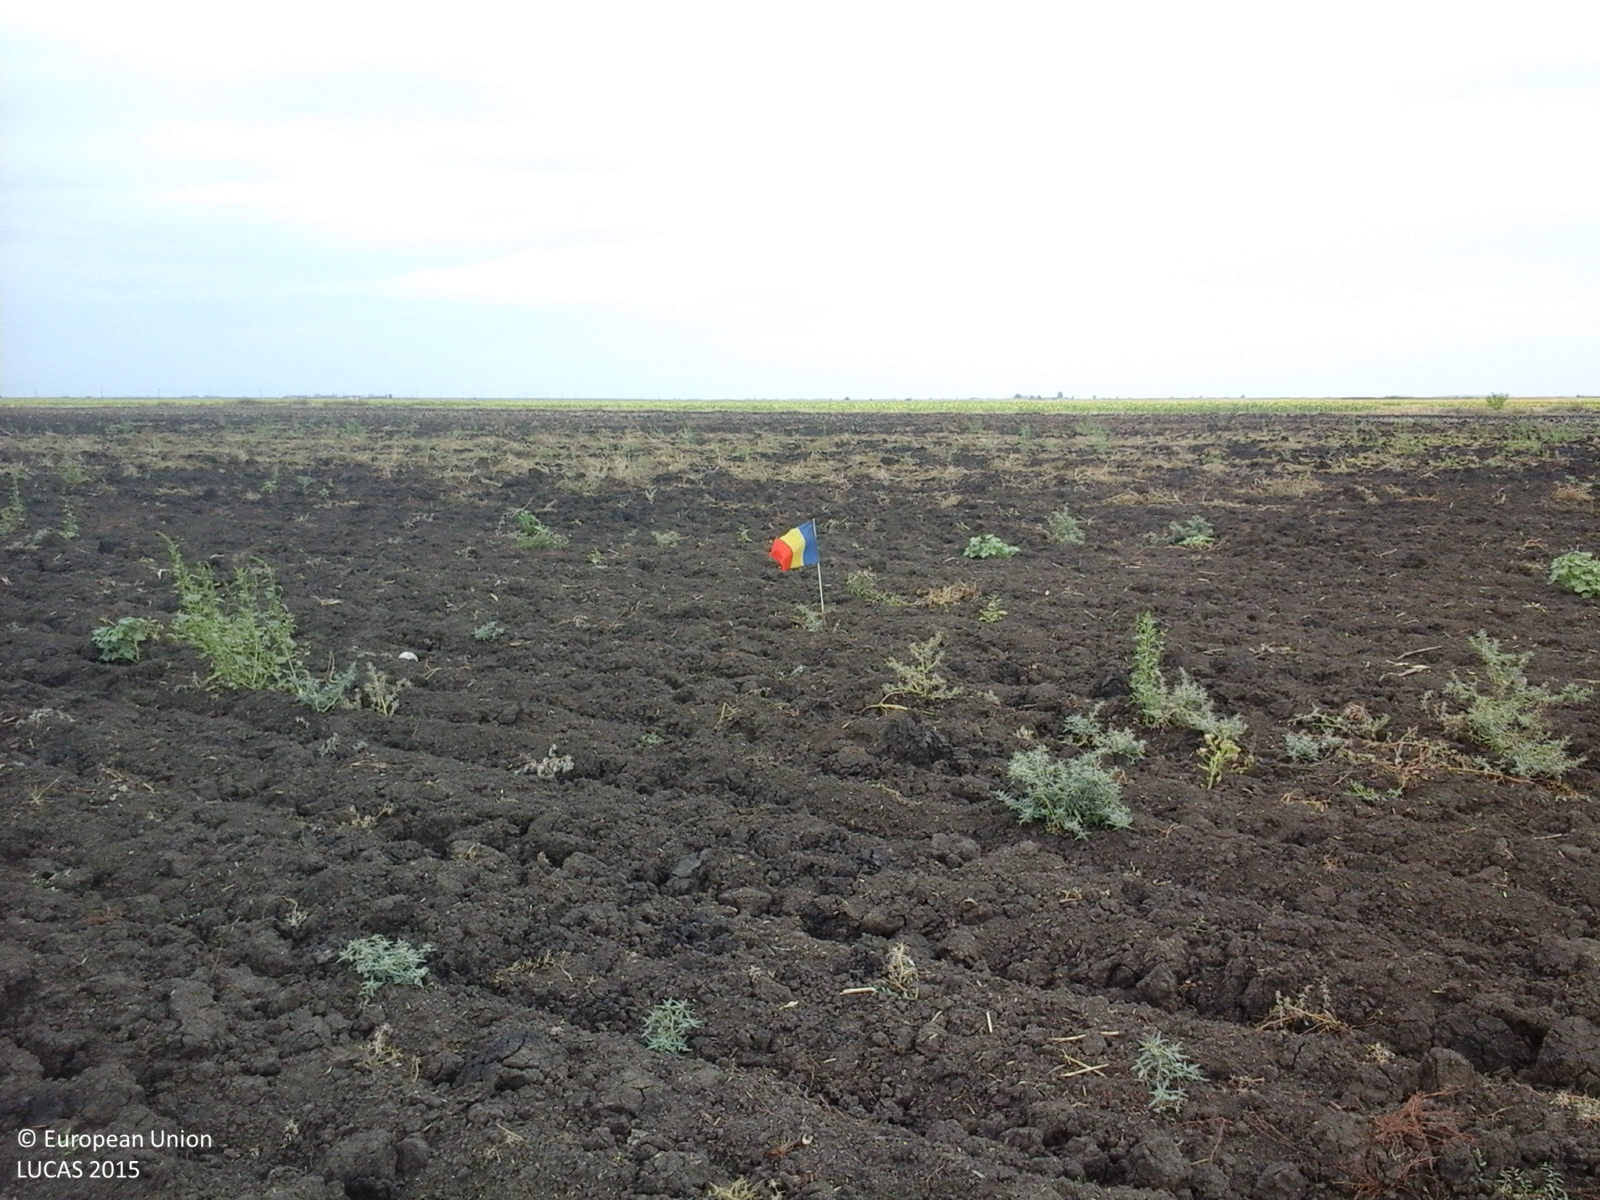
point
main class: Cropland
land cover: Rape and turnip rape
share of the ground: < 10 %
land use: Agriculture (excluding fallow land and kitchen gardens)
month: August
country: RO
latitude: 45.9918
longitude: 20.5466
